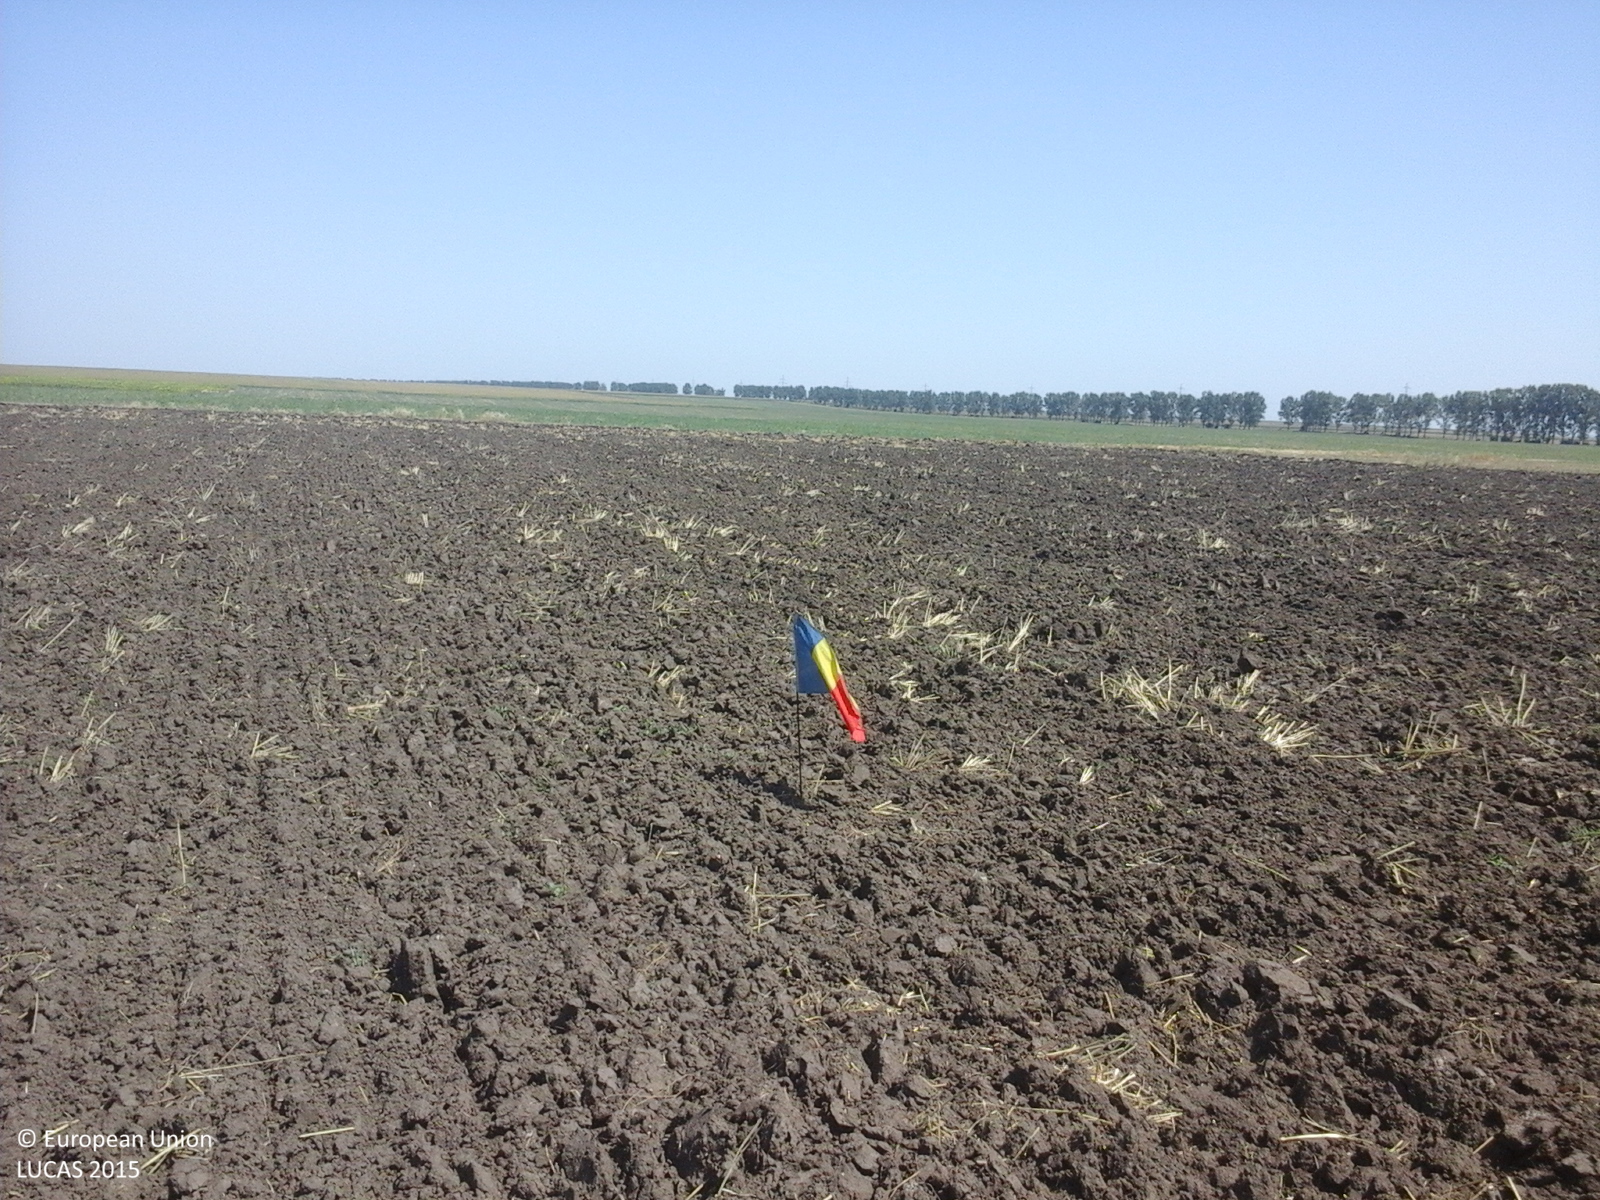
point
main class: Cropland
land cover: Common wheat
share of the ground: < 10 %
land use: Agriculture (excluding fallow land and kitchen gardens)
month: July
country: RO
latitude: 44.2467
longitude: 26.6341
